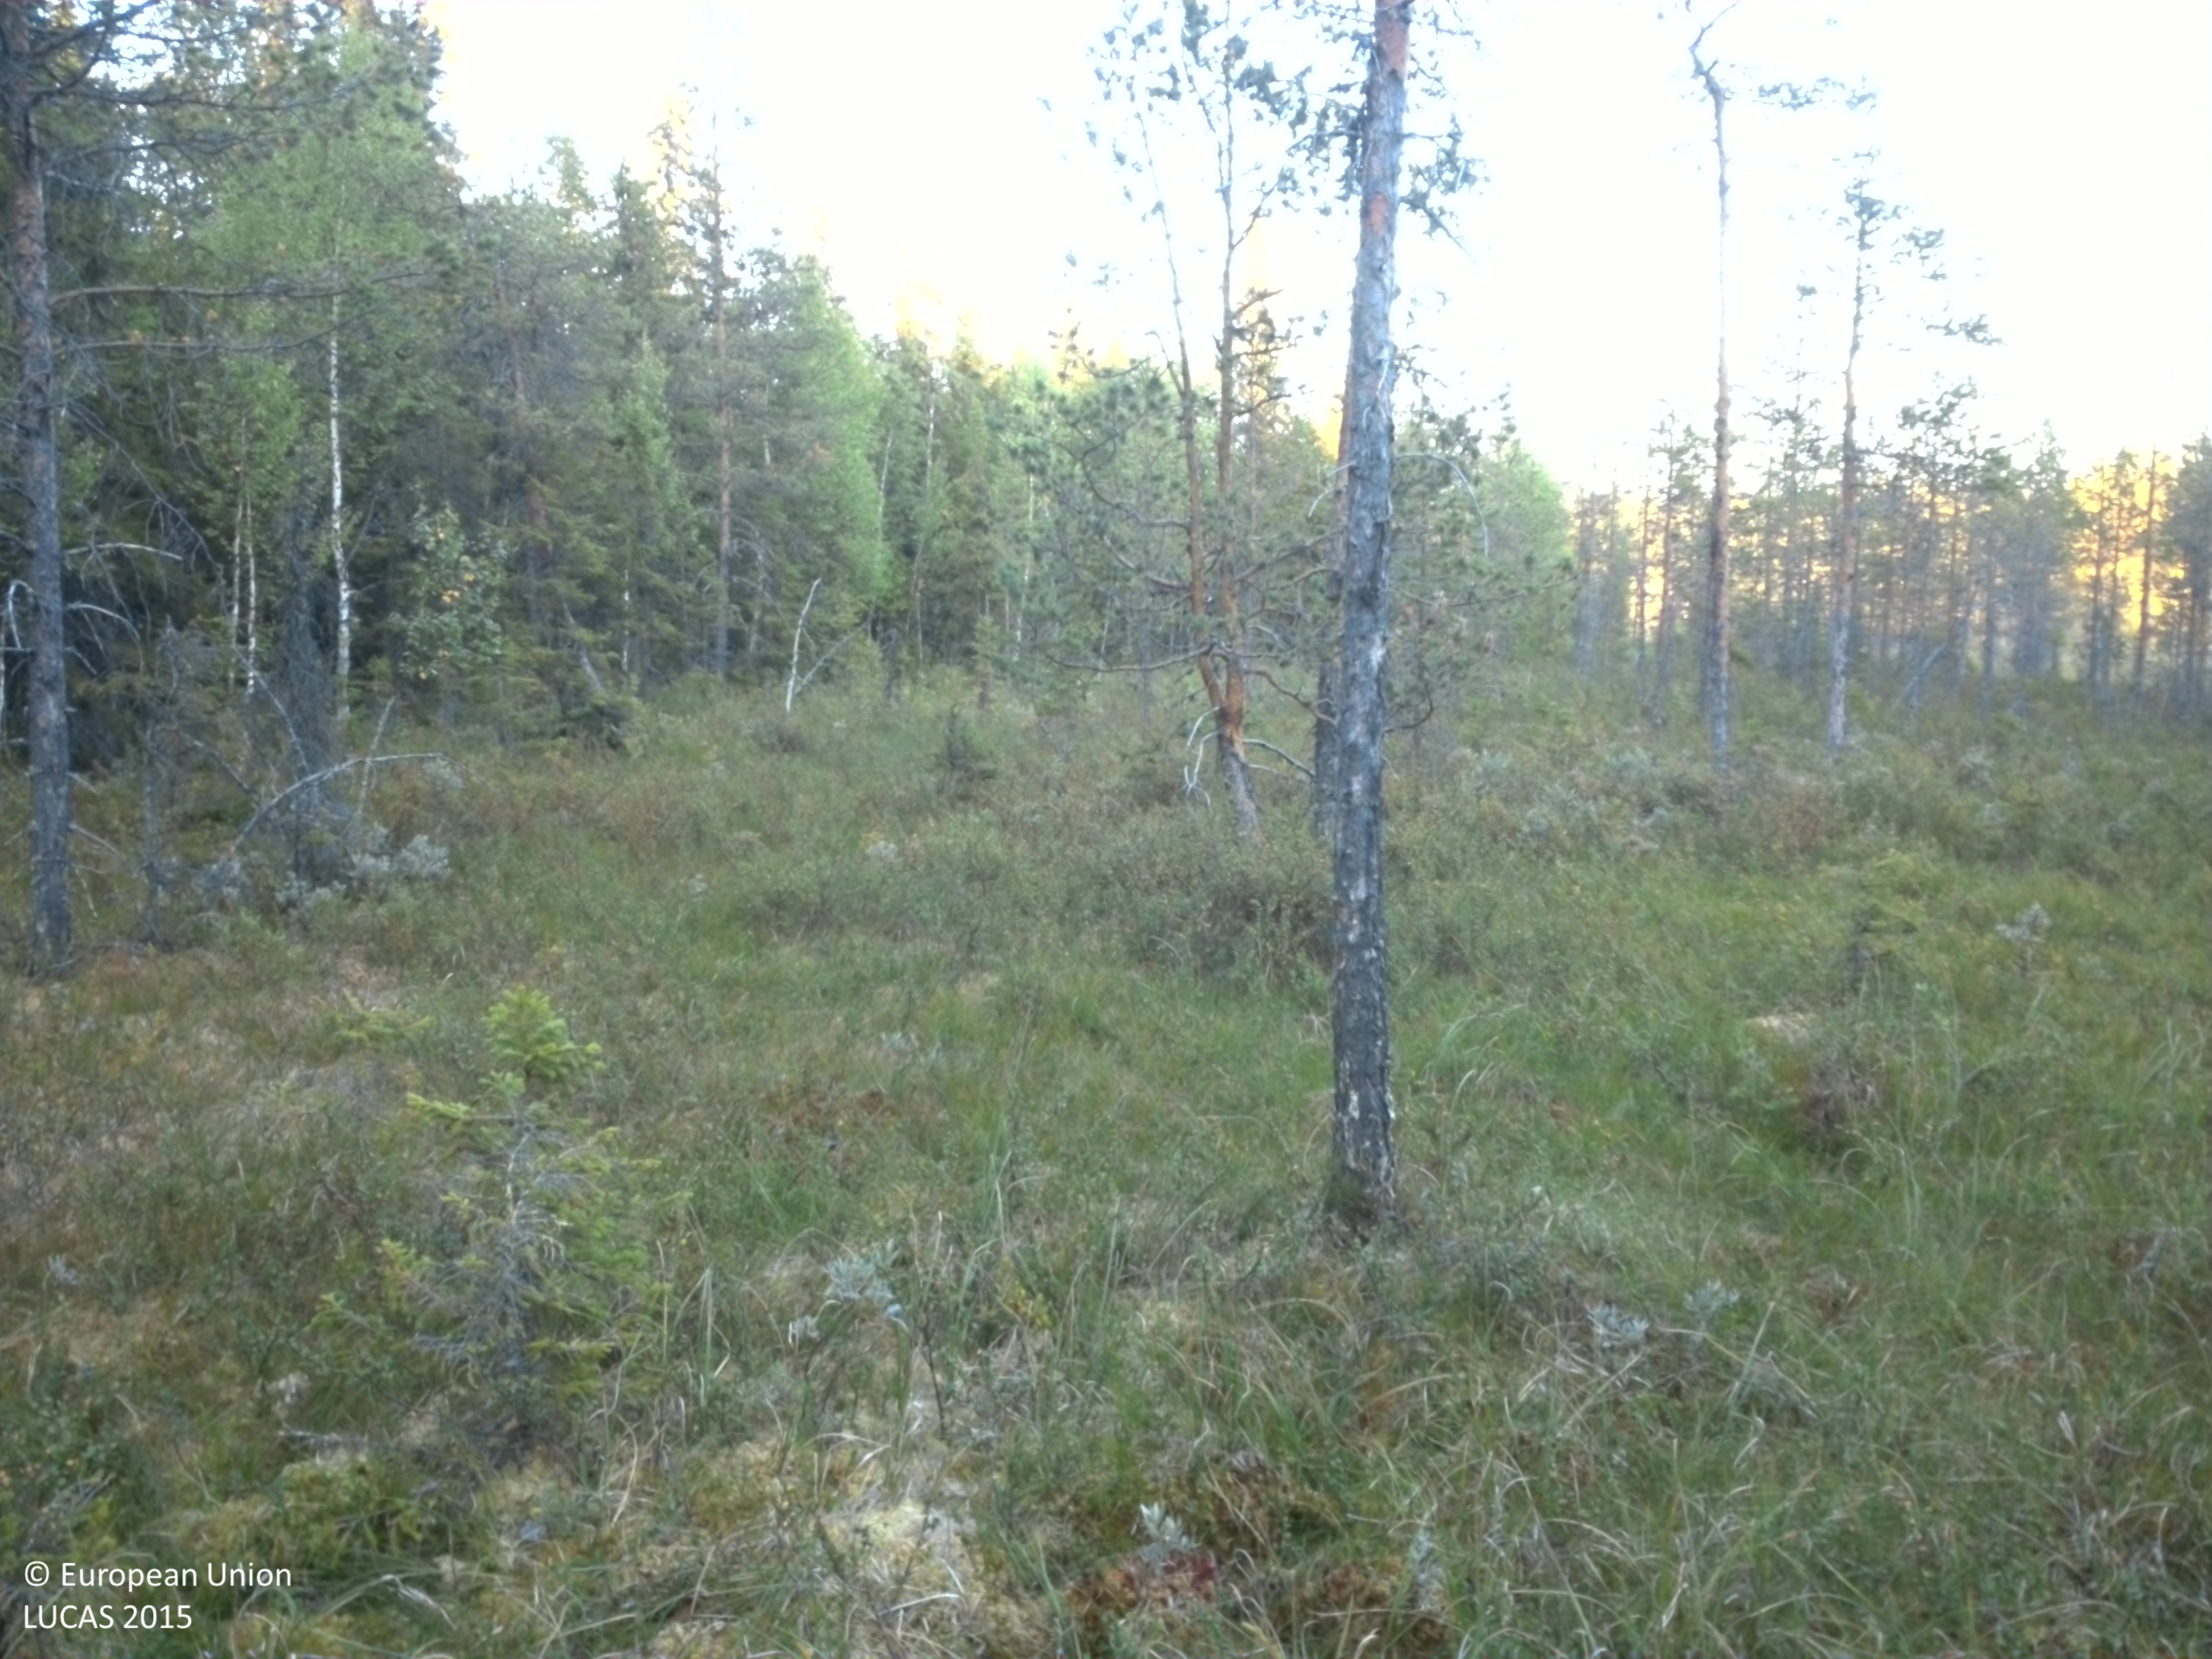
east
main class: Shrubland
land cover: Shrubland with sparse tree cover
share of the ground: 25 - 50 %
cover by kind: herbaceous plants 35 %, lichens and mosses 35 %, shrubs 25 %, coniferous forest trees 5 %
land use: Semi-natural and natural areas not in use
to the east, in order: Shrubland with sparse tree cover; Pine dominated coniferous woodland; Spruce dominated mixed woodland; Shrubland with sparse tree cover; Pine dominated coniferous woodland; Other coniferous woodland; Spruce dominated coniferous woodland
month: August
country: SE
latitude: 64.7065
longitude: 16.7836
